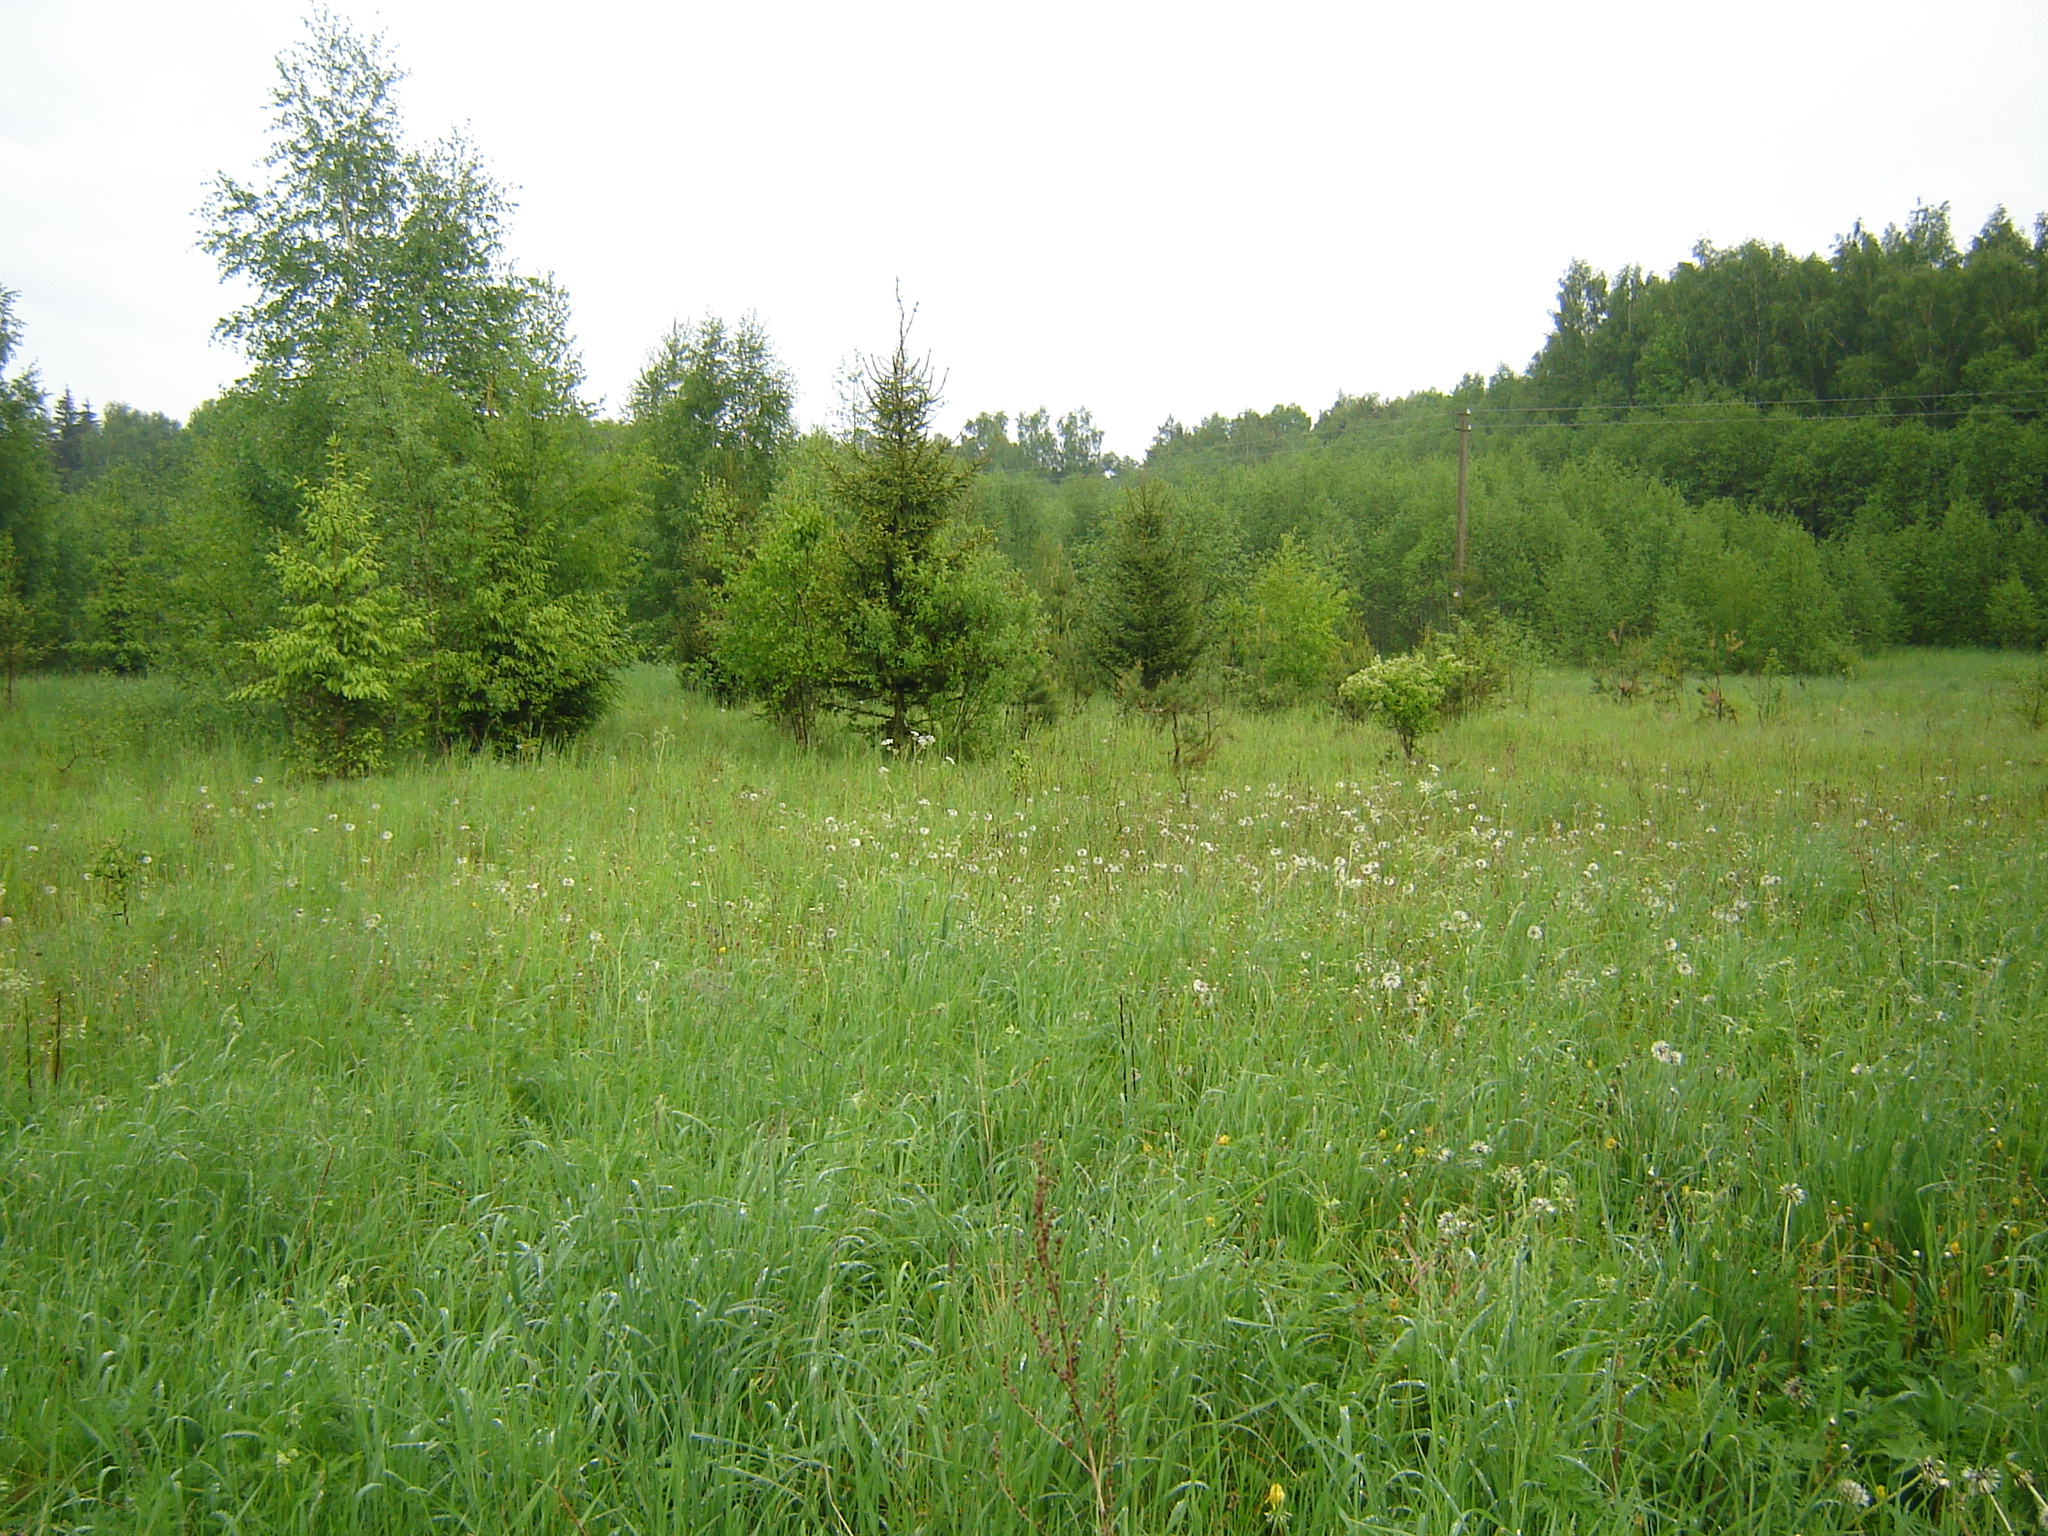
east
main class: Grassland
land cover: Grassland without tree/shrub cover
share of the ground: > 75 %
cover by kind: herbaceous plants 100 %
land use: Agriculture (excluding fallow land and kitchen gardens)
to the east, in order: Grassland without tree/shrub cover; Spruce dominated mixed woodland; Electric lines; Broadleaved woodland; Grassland without tree/shrub cover; Tracks; Grassland without tree/shrub cover; Broadleaved woodland; Spruce dominated coniferous woodland
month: May
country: LT
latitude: 55.8946
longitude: 25.2276
